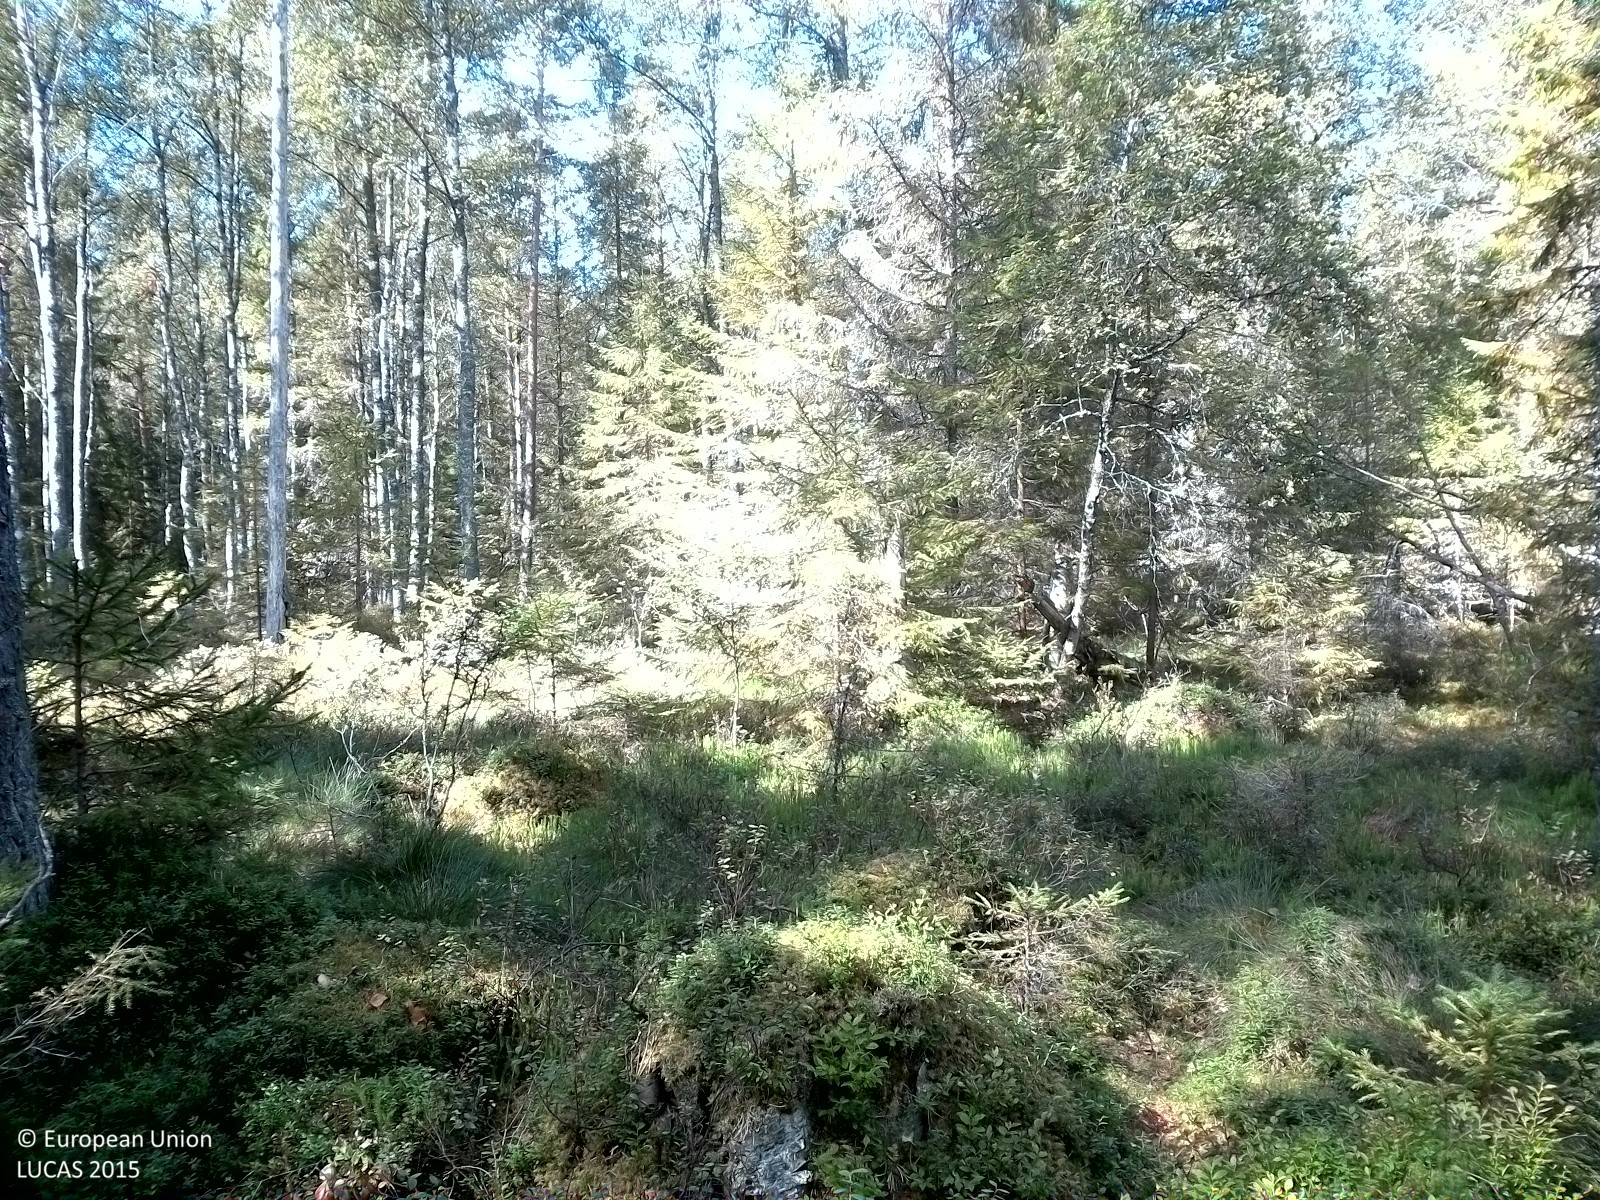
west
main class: Woodland
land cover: Other mixed woodland
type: boreal forest
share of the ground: 25 - 50 %
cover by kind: herbaceous plants 40 %, coniferous forest trees 25 %, broadleaved forest trees 15 %, lichens and mosses 15 %, shrubs 5 %
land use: Forestry
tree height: > 5 m
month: August
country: SE
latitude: 59.0758
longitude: 15.6276
